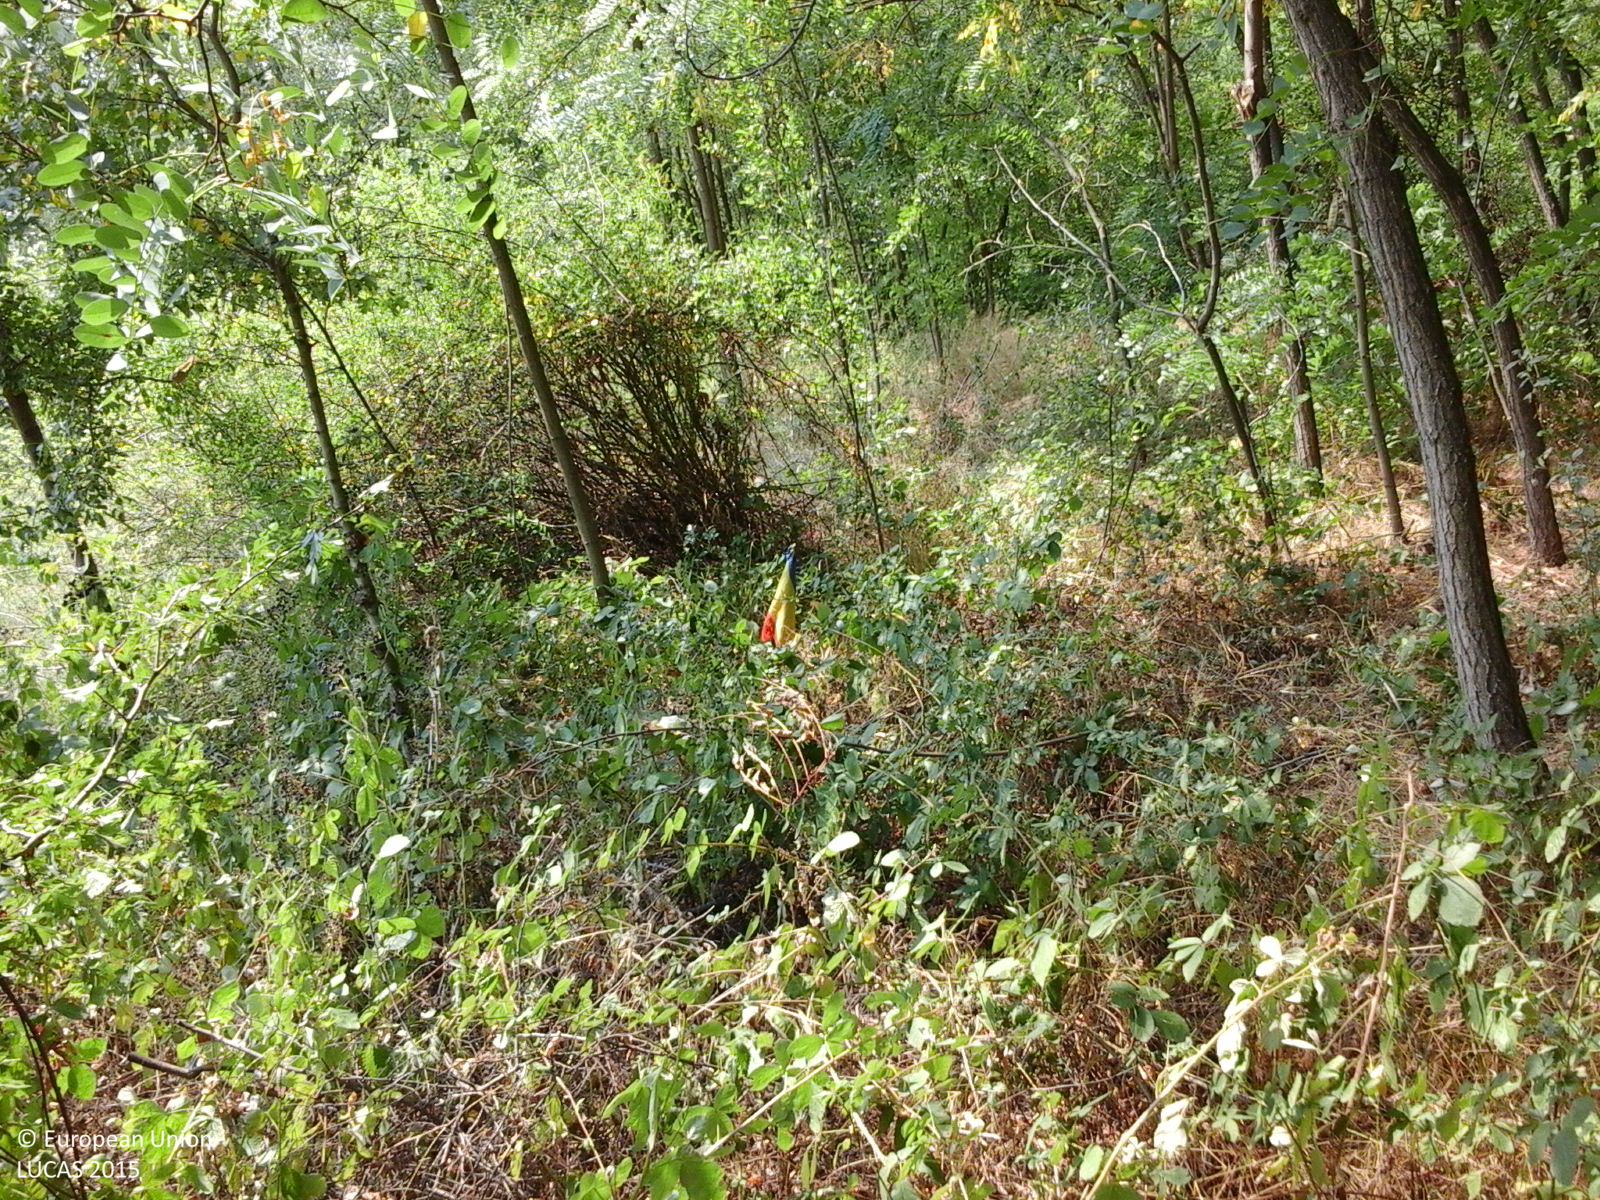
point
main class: Woodland
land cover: Broadleaved woodland
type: exotic forest
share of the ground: > 75 %
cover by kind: broadleaved forest trees 100 %
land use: Forestry
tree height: > 5 m
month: August
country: RO
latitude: 44.5211
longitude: 23.3753
